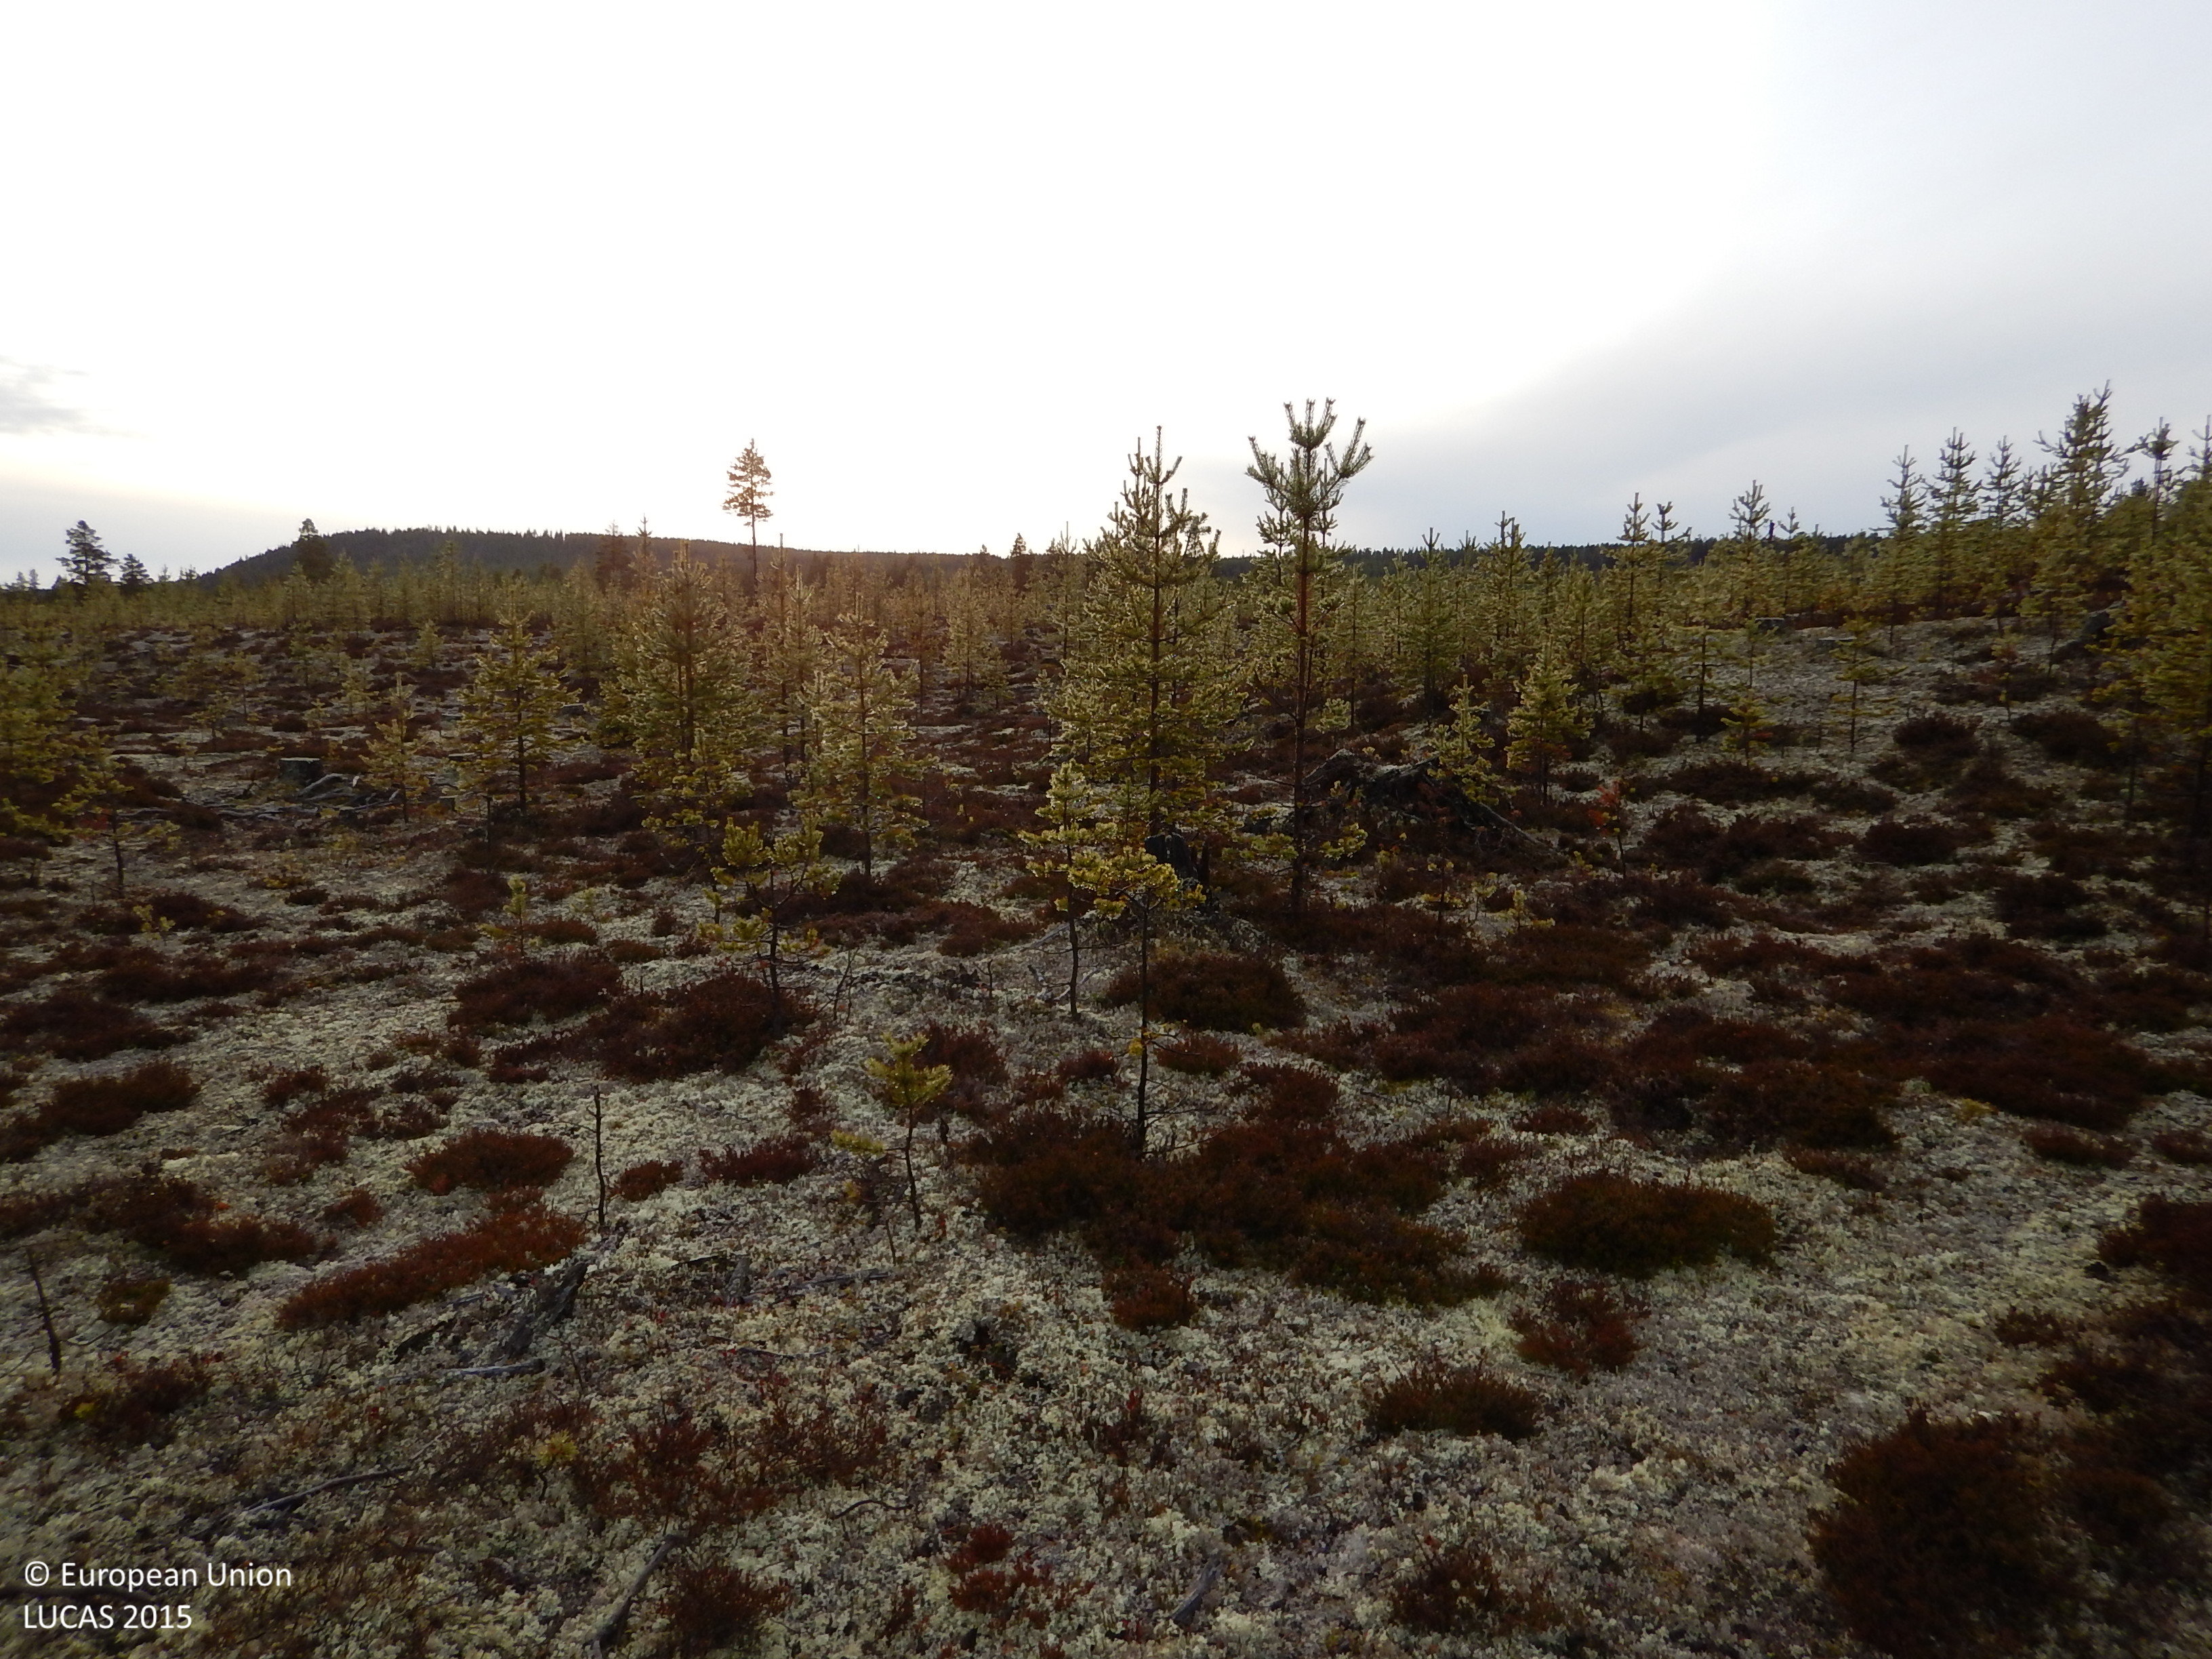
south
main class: Woodland
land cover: Pine dominated coniferous woodland
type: boreal forest
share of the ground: 25 - 50 %
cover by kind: lichens and mosses 40 %, coniferous forest trees 35 %, shrubs 20 %, herbaceous plants 5 %
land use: Forestry
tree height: < 5 m
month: November
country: SE
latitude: 65.1716
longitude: 20.3640
